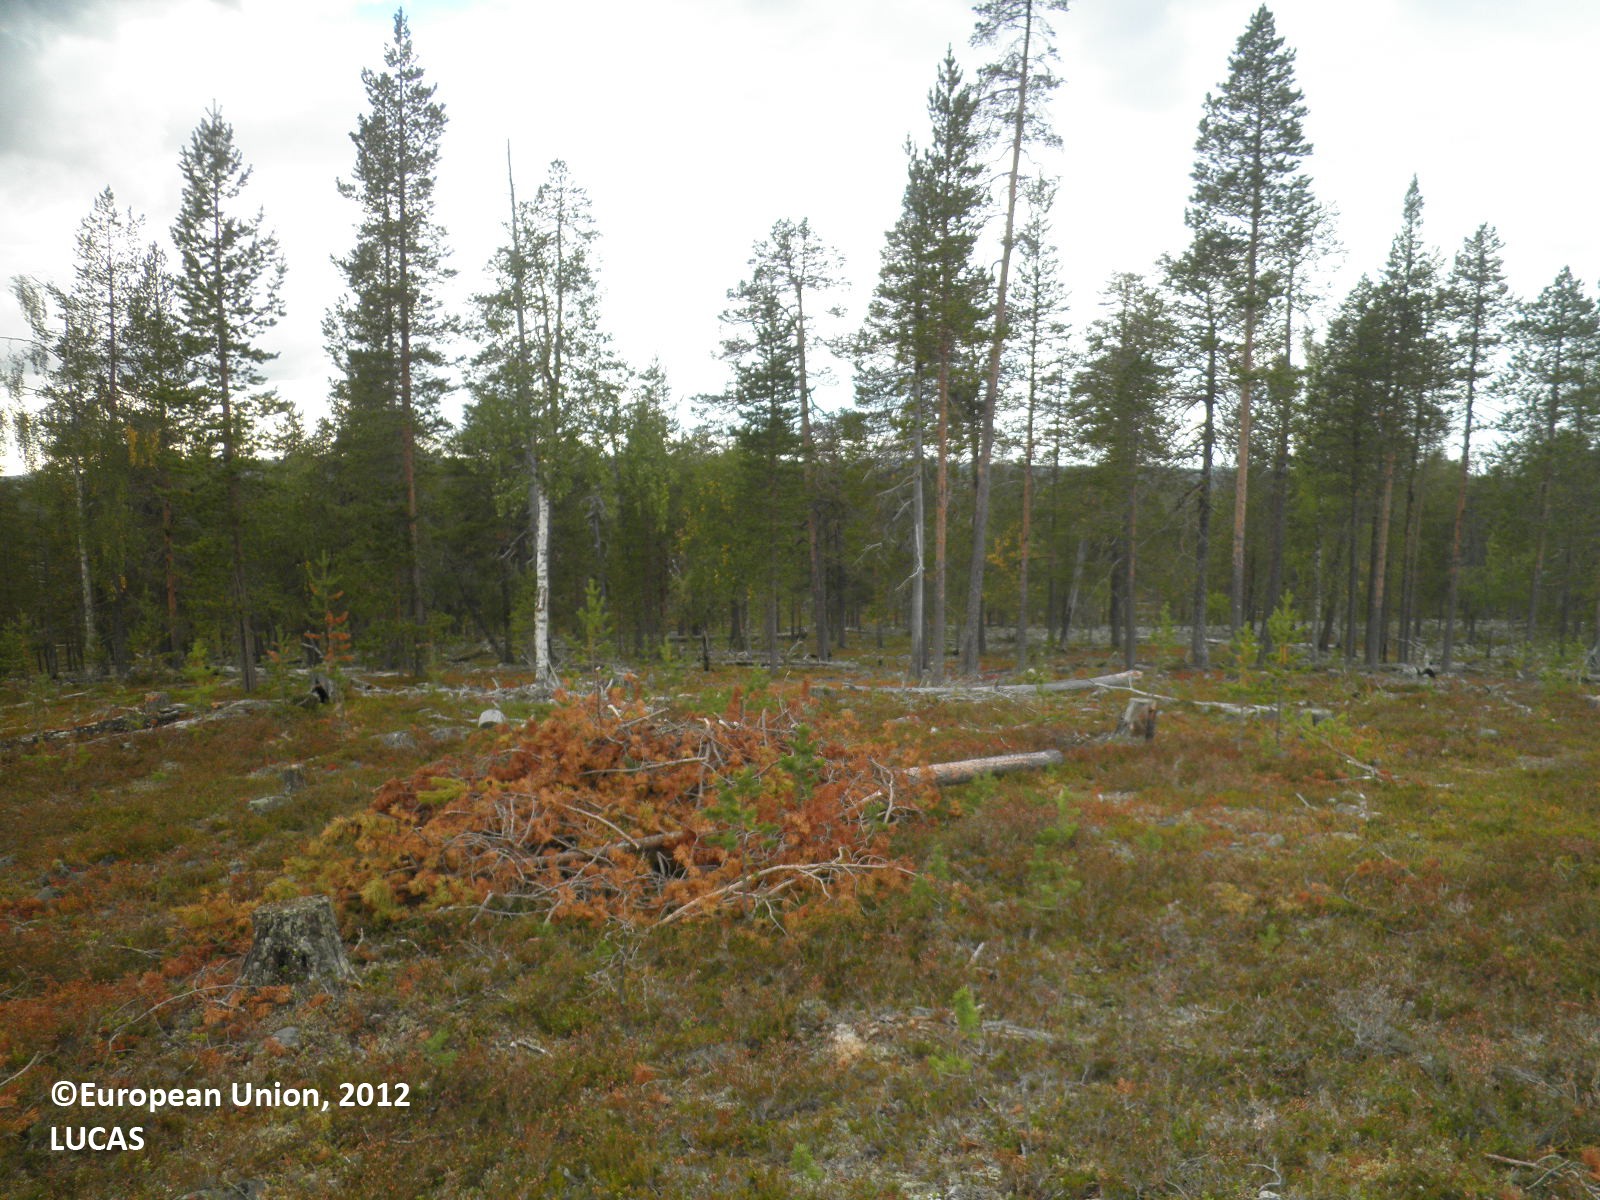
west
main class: Woodland
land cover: Pine dominated coniferous woodland
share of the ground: 10 - 25 %
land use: Forestry
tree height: < 5 m
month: August
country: FI
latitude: 67.9261
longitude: 28.2588
